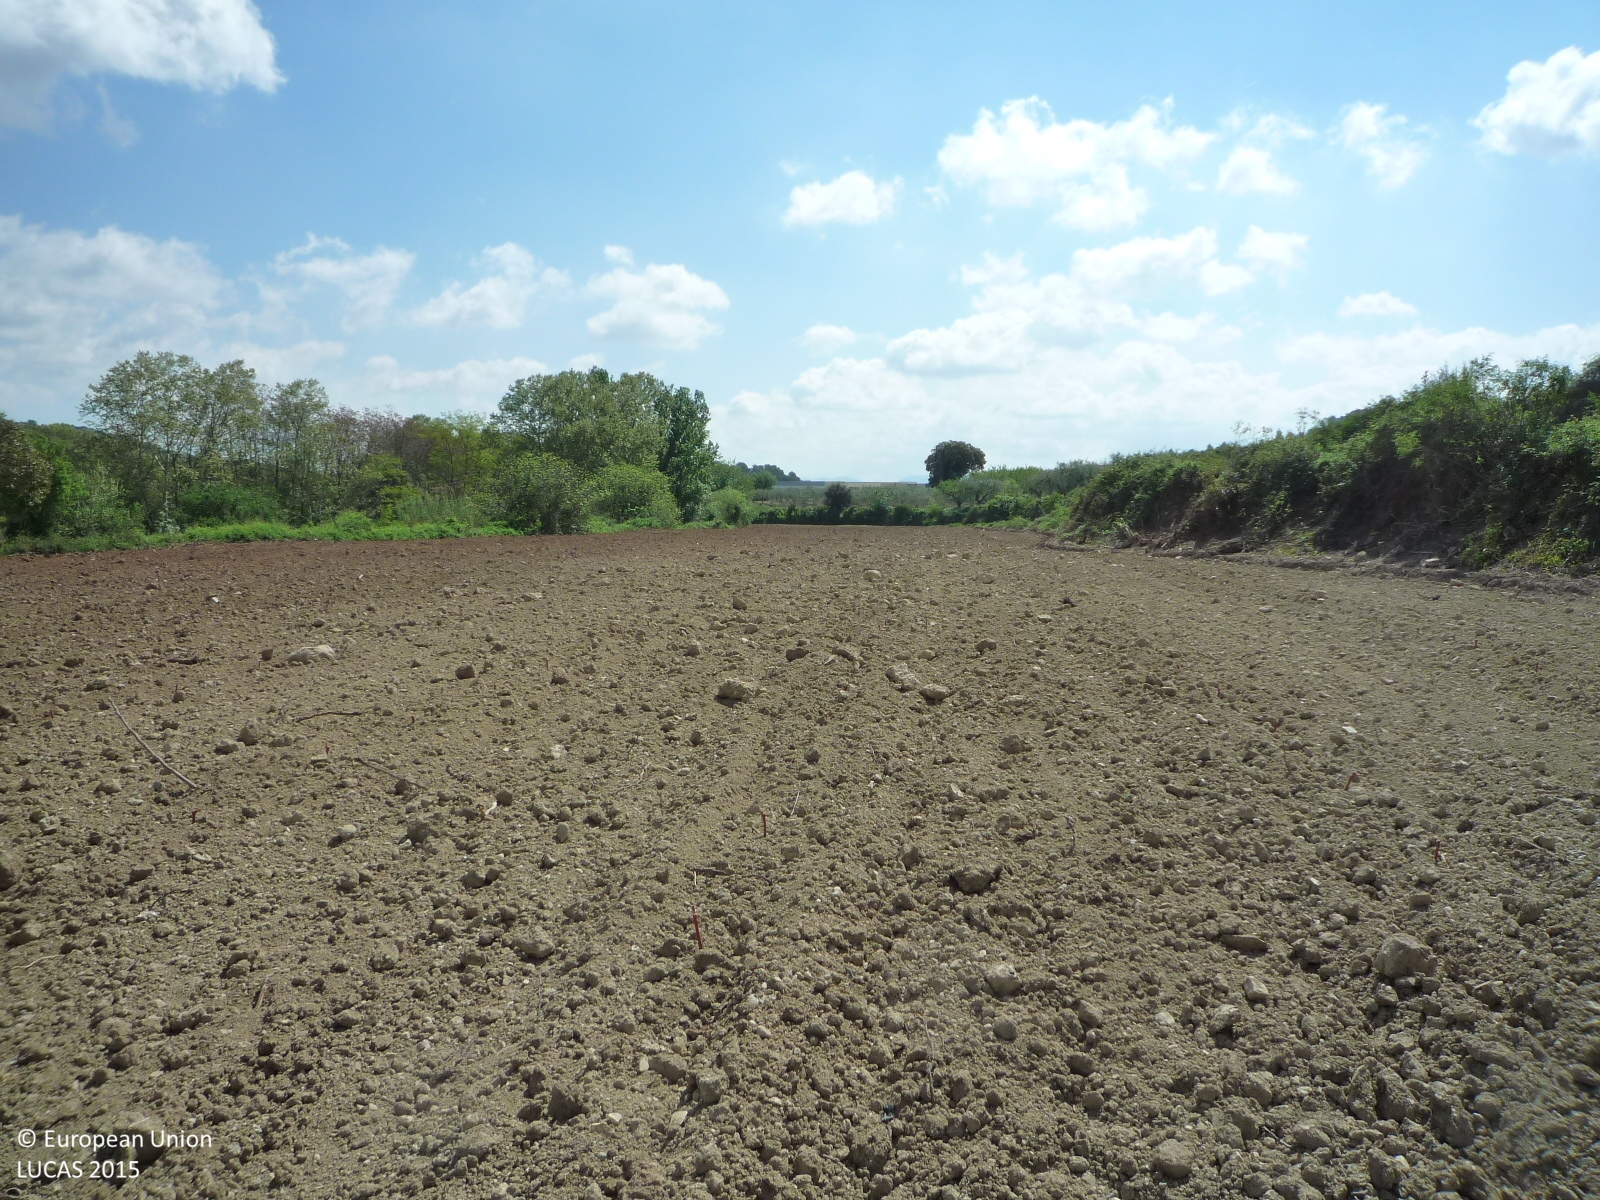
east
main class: Cropland
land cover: Vineyards
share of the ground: < 10 %
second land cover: Other bare soil
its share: > 75 %
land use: Agriculture (excluding fallow land and kitchen gardens)
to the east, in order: Vineyards; Other bare soil; Shrubland with sparse tree cover; Other fresh vegetables; Ditches and canals; Other fresh vegetables; Broadleaved woodland; Ditches and canals; Grassland without tree/shrub cover
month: April
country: ES
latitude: 41.4574
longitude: 1.6723
